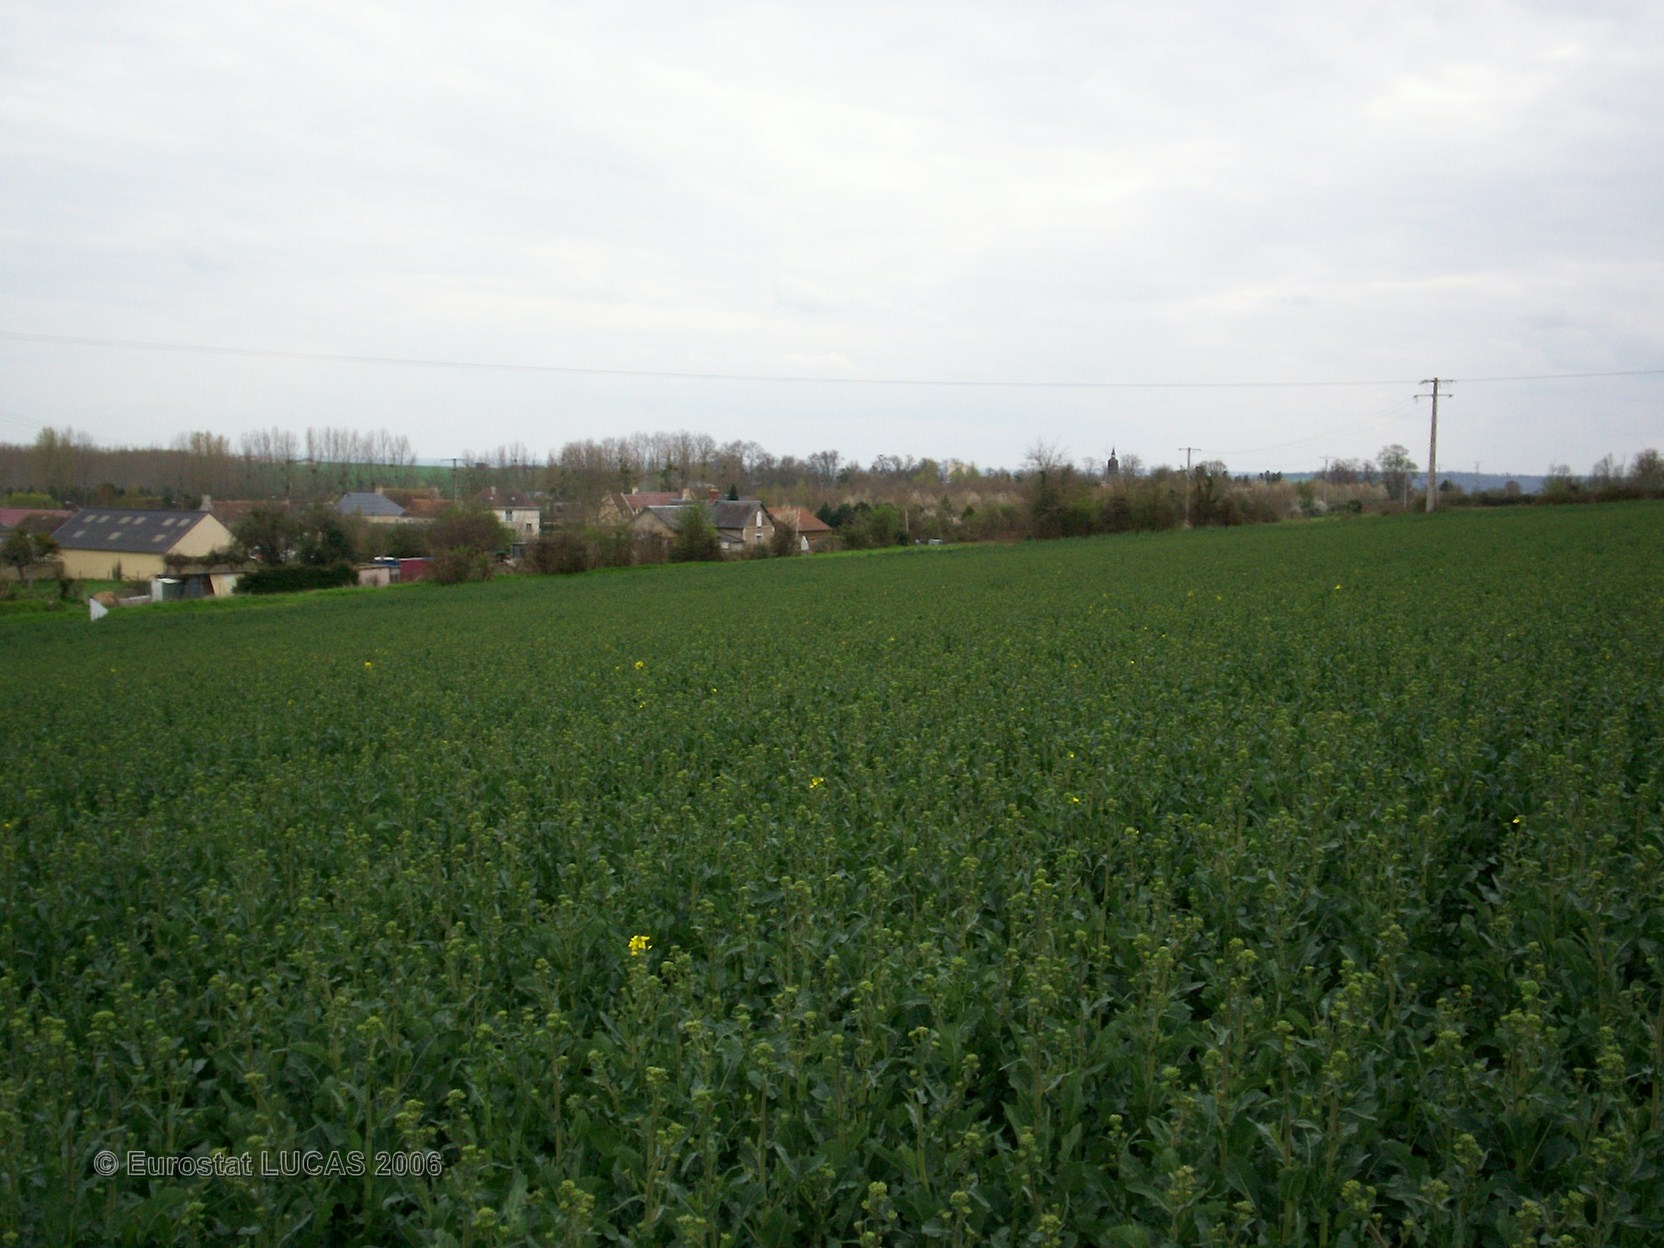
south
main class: Cropland
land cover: Rape and turnip rape
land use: Agriculture (excluding fallow land and kitchen gardens)
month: April
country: FR
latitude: 48.9935
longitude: -0.0768
